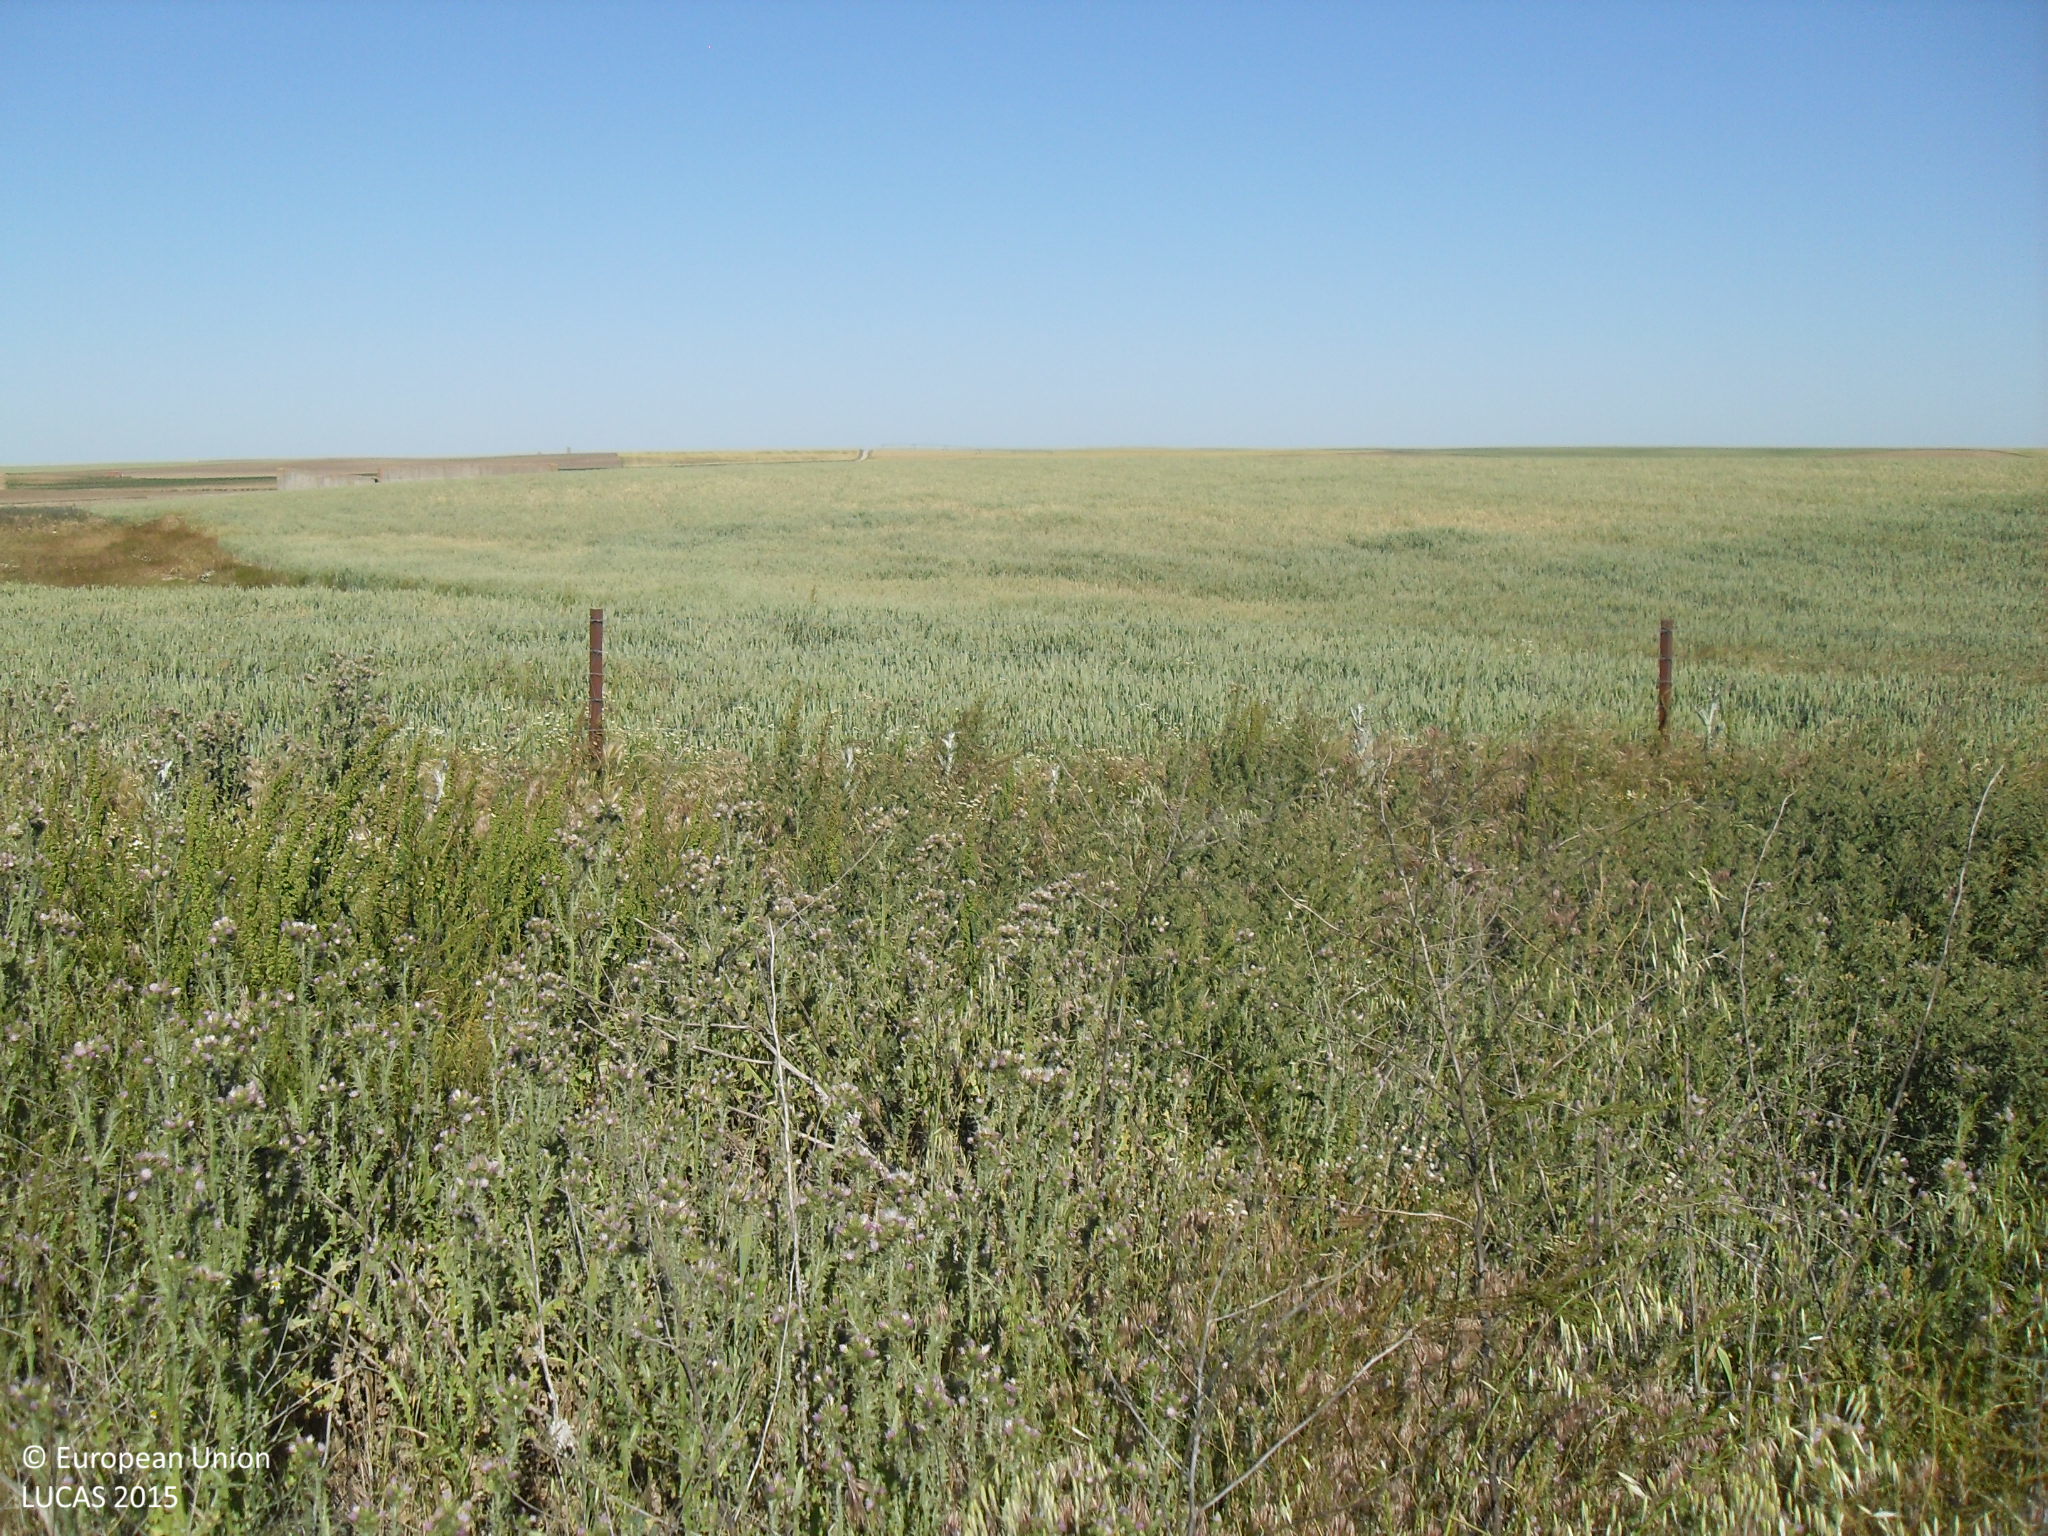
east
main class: Woodland
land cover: Pine dominated coniferous woodland
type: coniferous forest of the mediterranean region
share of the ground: 50 - 75 %
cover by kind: coniferous forest trees 60 %, herbaceous plants 40 %
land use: Forestry
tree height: < 5 m
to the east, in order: Pine dominated coniferous woodland; Fences; Common wheat; Ditches and canals; Common wheat
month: May
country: ES
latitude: 41.0135
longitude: -5.2548
